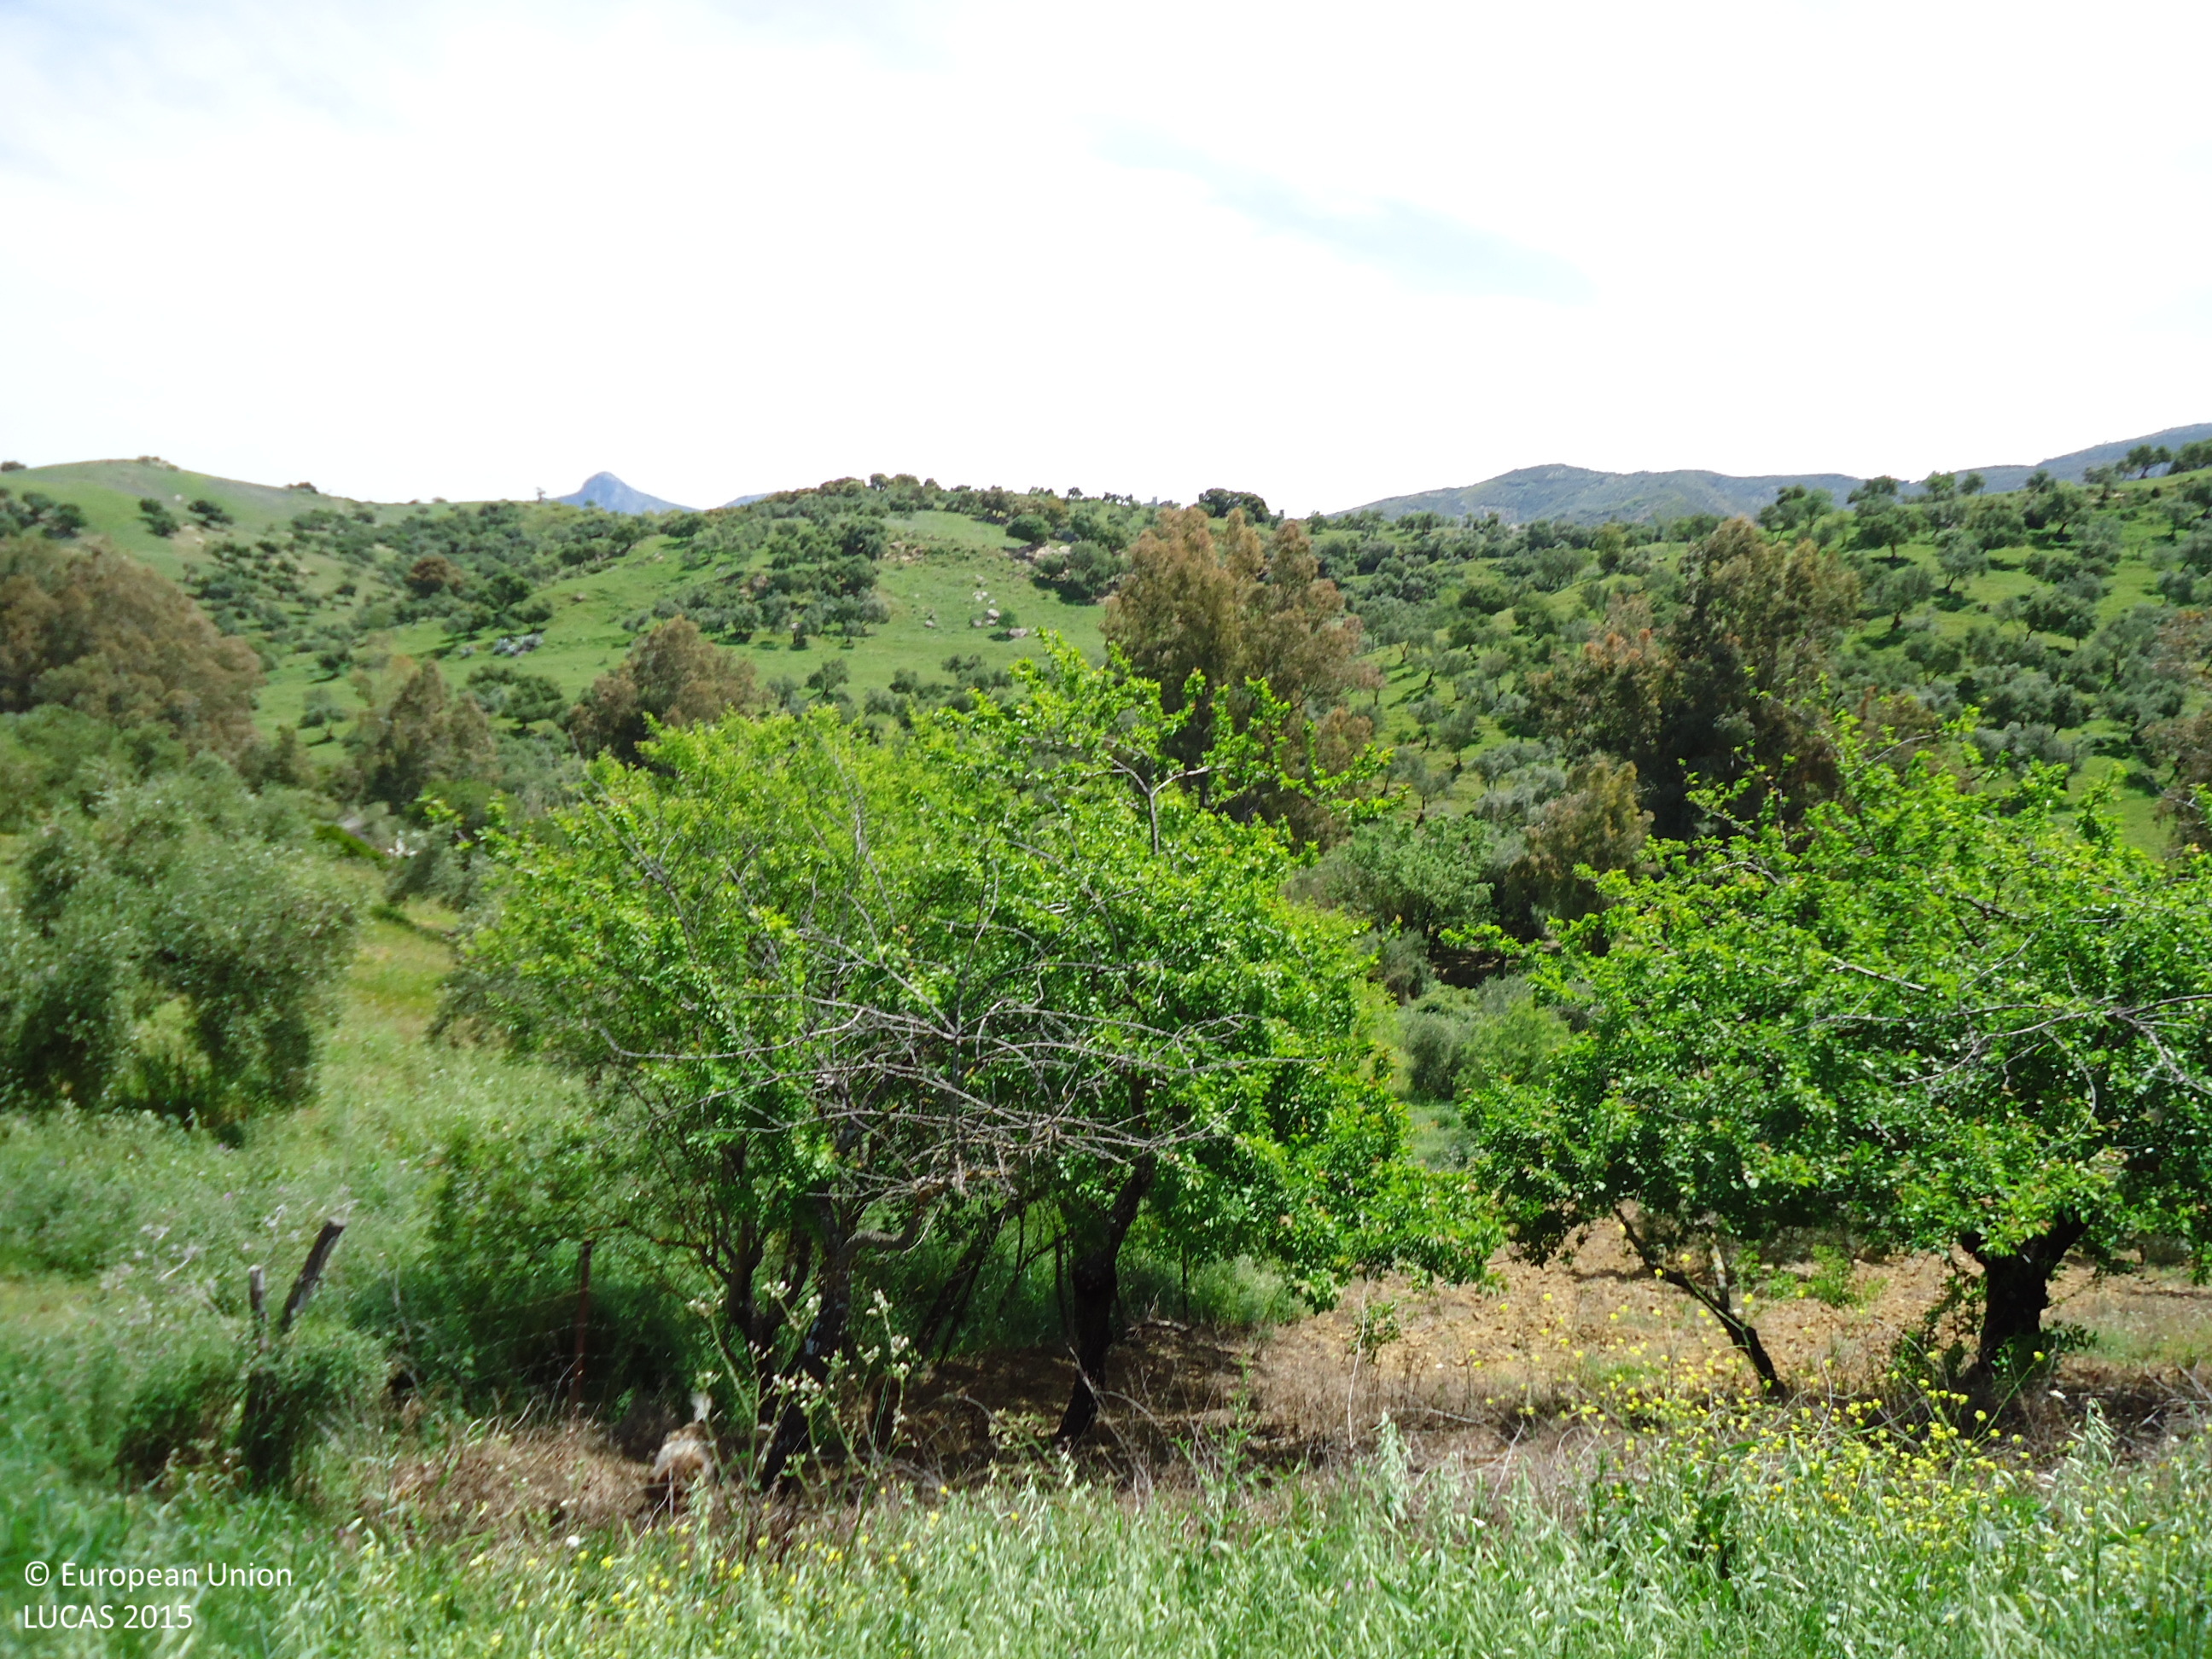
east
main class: Cropland
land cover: Oats
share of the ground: > 75 %
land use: Agriculture (excluding fallow land and kitchen gardens)
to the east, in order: Oats; Fences; Olive groves; Shrubland with sparse tree cover; Olive groves; Fences; Shrubland with sparse tree cover; Rivers and streams; Broadleaved woodland; Permanent crops (only in case pi); Grassland without tree/shrub cover
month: April
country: ES
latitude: 36.8492
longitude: -5.4253
